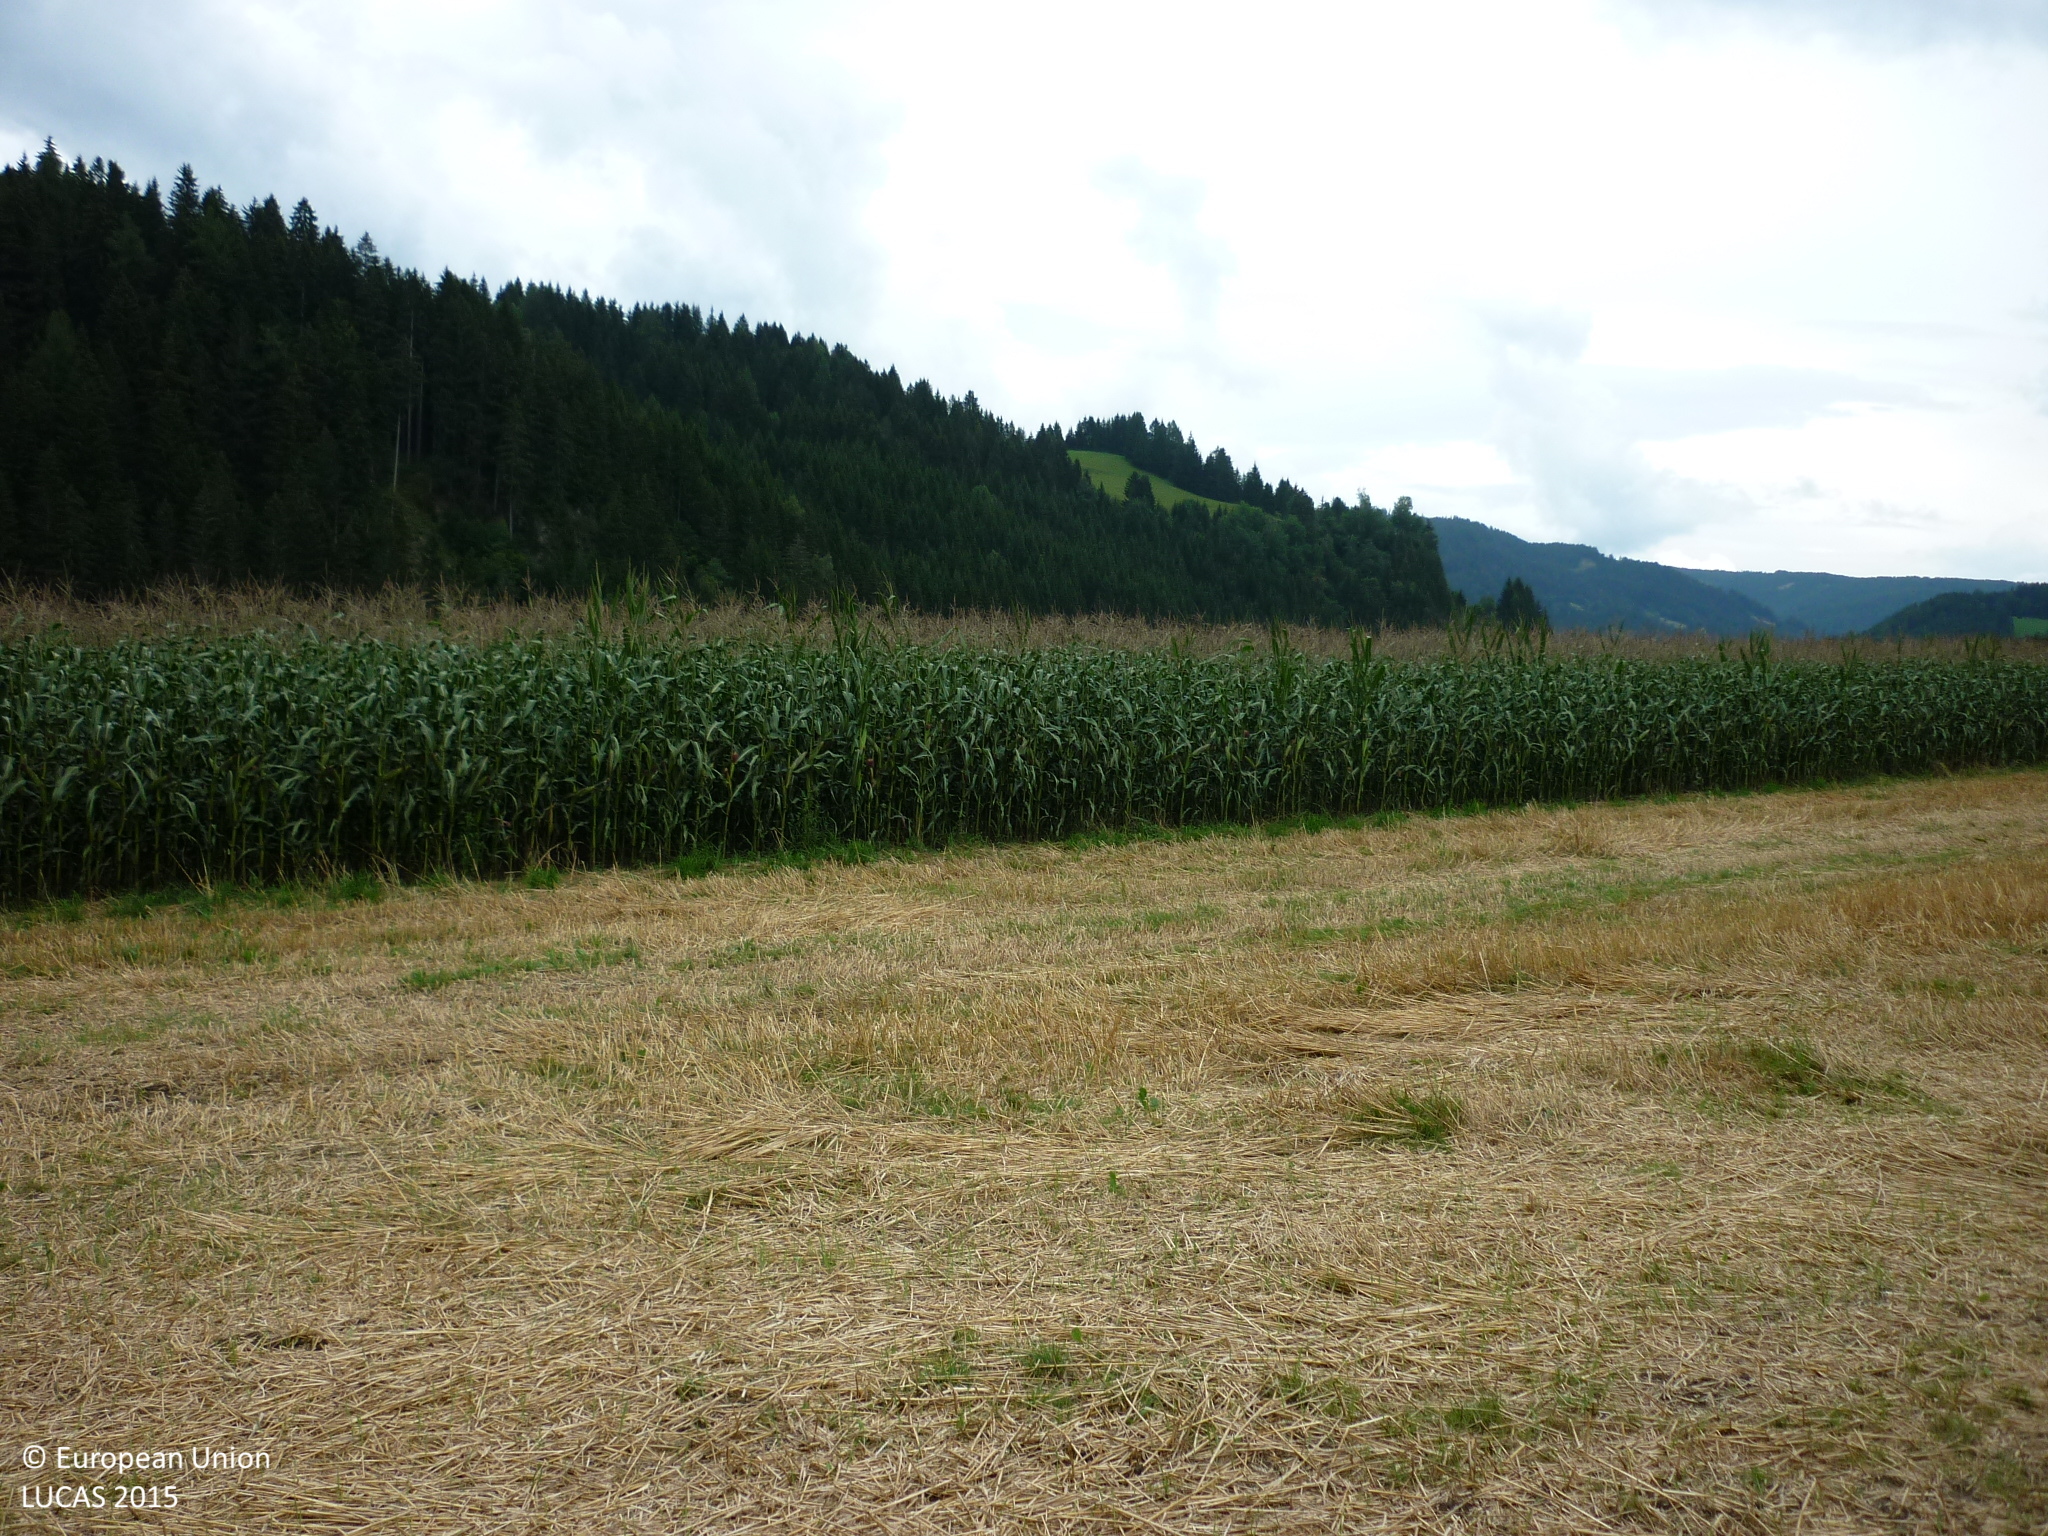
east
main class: Cropland
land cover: Common wheat
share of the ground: > 75 %
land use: Agriculture (excluding fallow land and kitchen gardens)
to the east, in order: Common wheat; Maize; Grassland without tree/shrub cover; Tracks; Grassland without tree/shrub cover
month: August
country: AT
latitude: 47.0147
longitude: 14.4841
